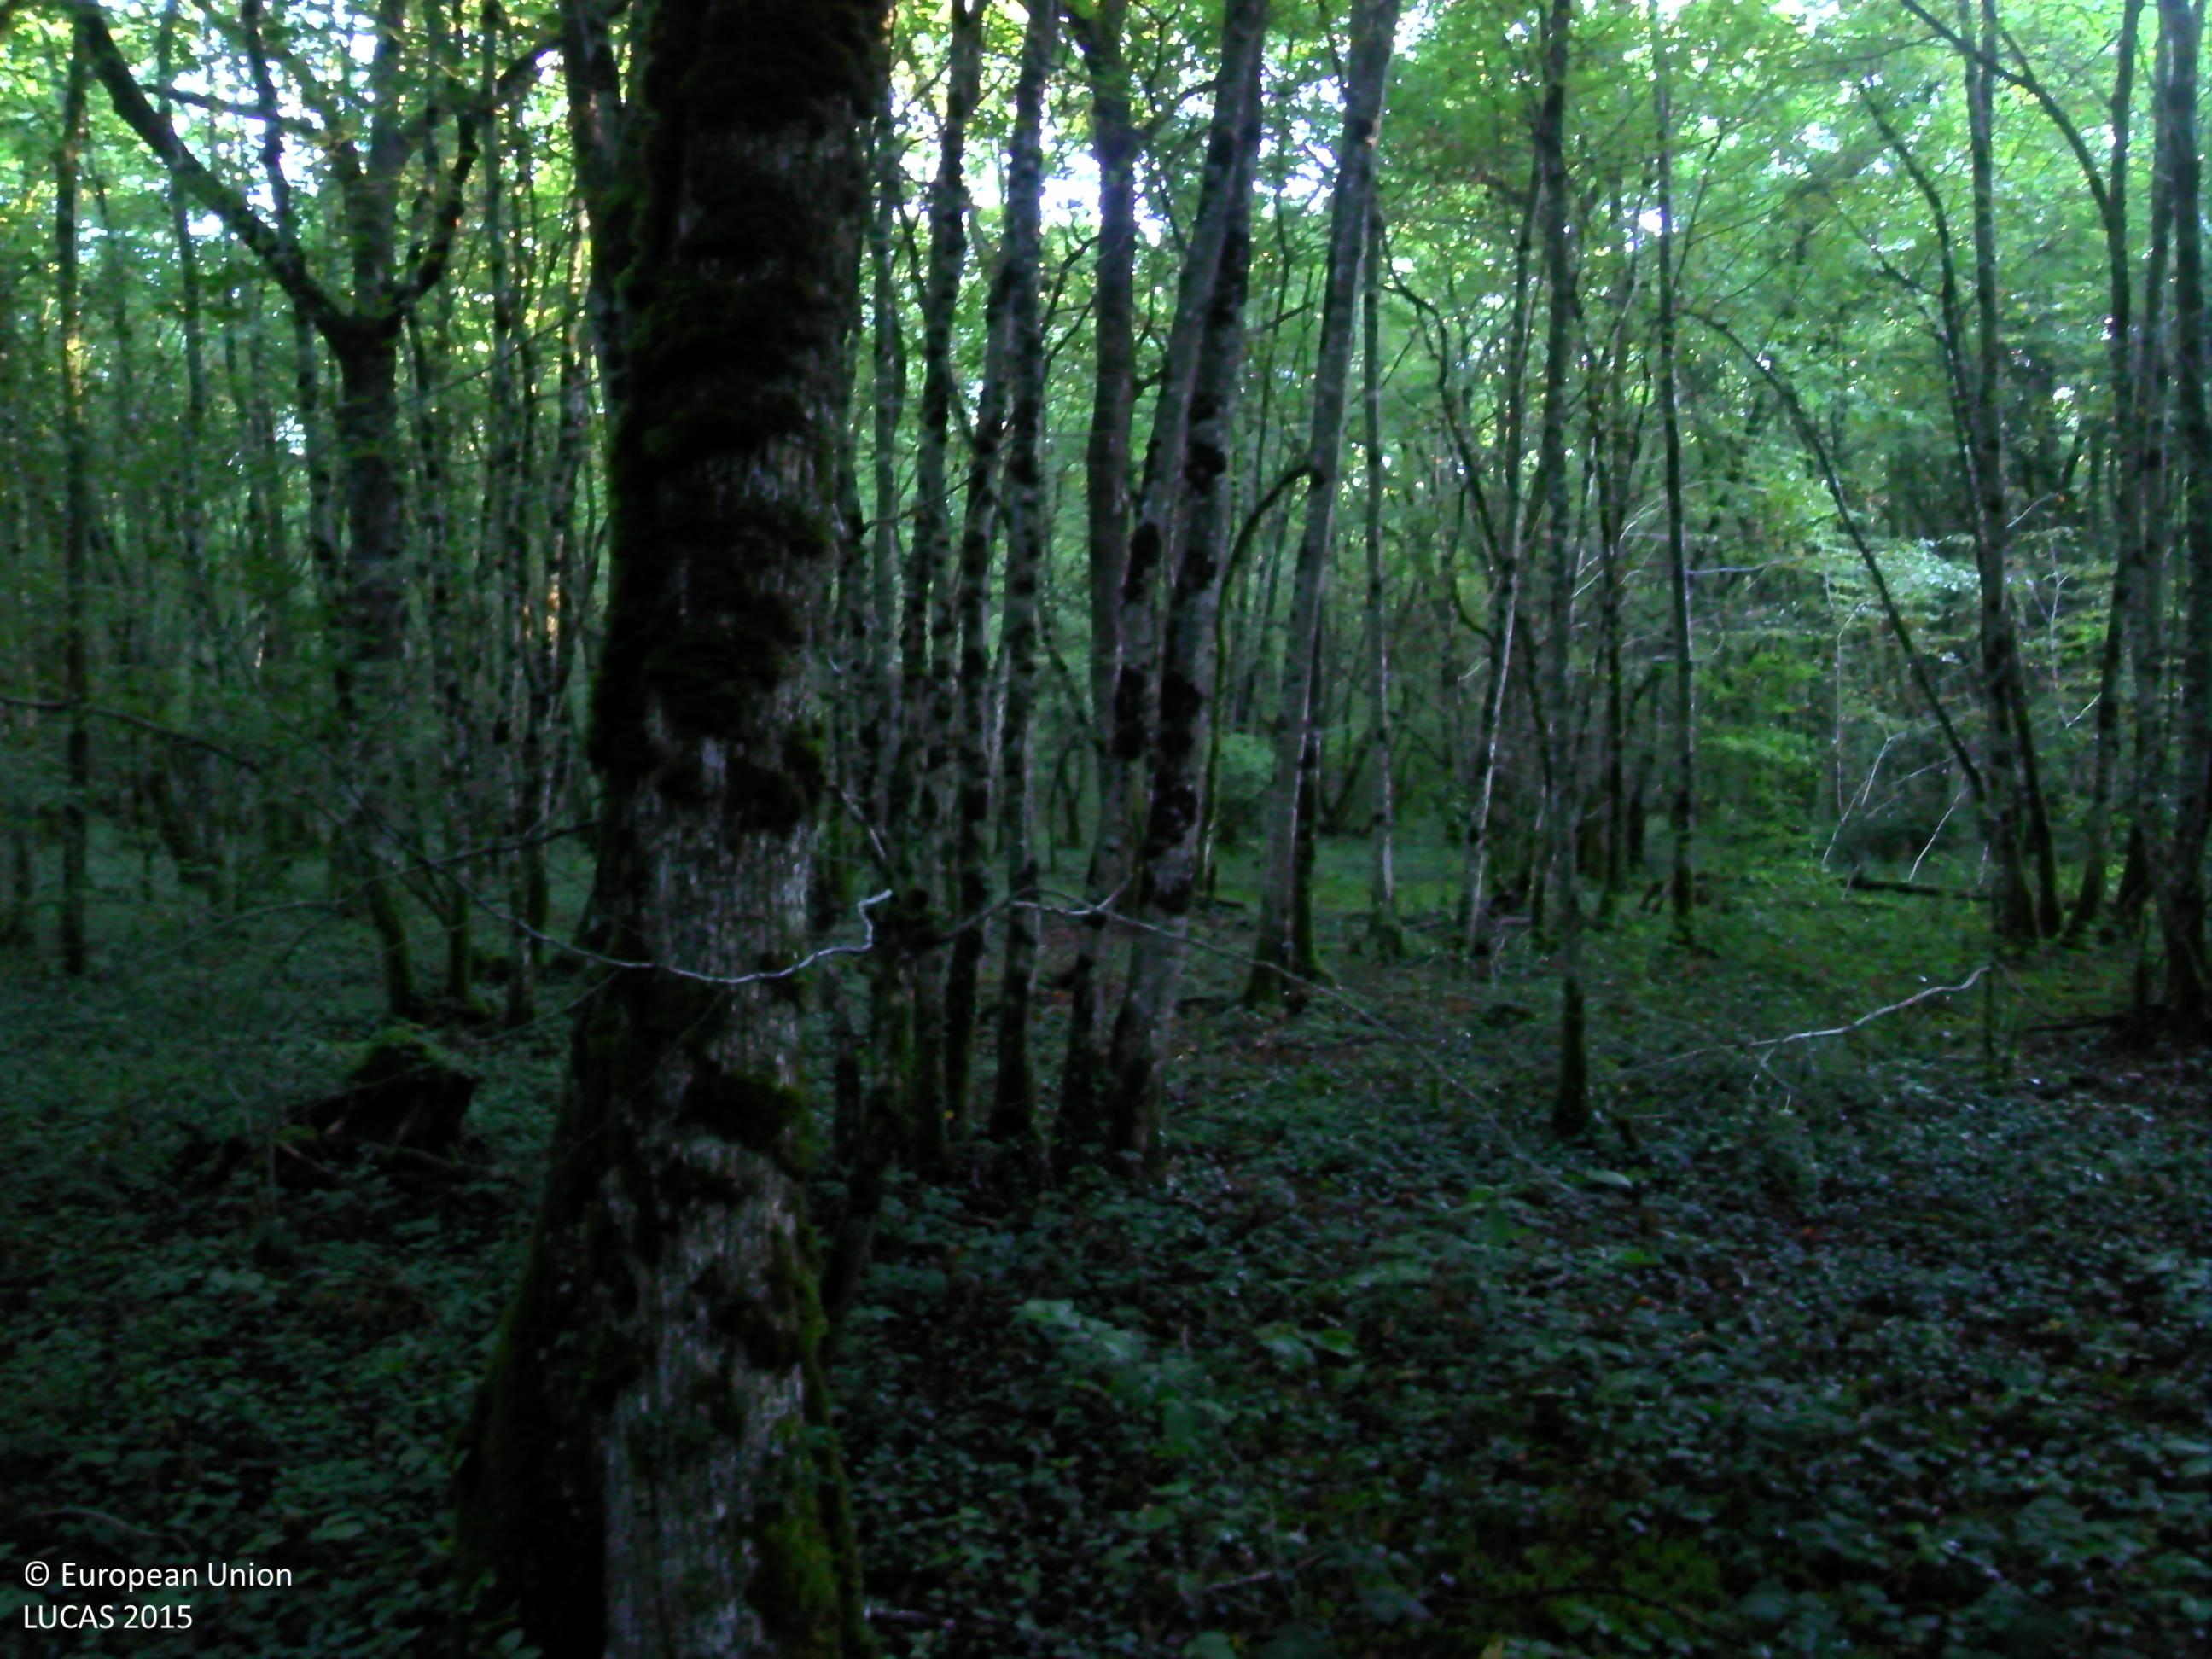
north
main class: Woodland
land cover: Broadleaved woodland
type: mesophytic deciduous forest
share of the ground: > 75 %
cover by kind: broadleaved forest trees 85 %, herbaceous plants 10 %, lichens and mosses 5 %
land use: Forestry
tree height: > 5 m
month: September
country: FR
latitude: 48.1381
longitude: 4.8248
